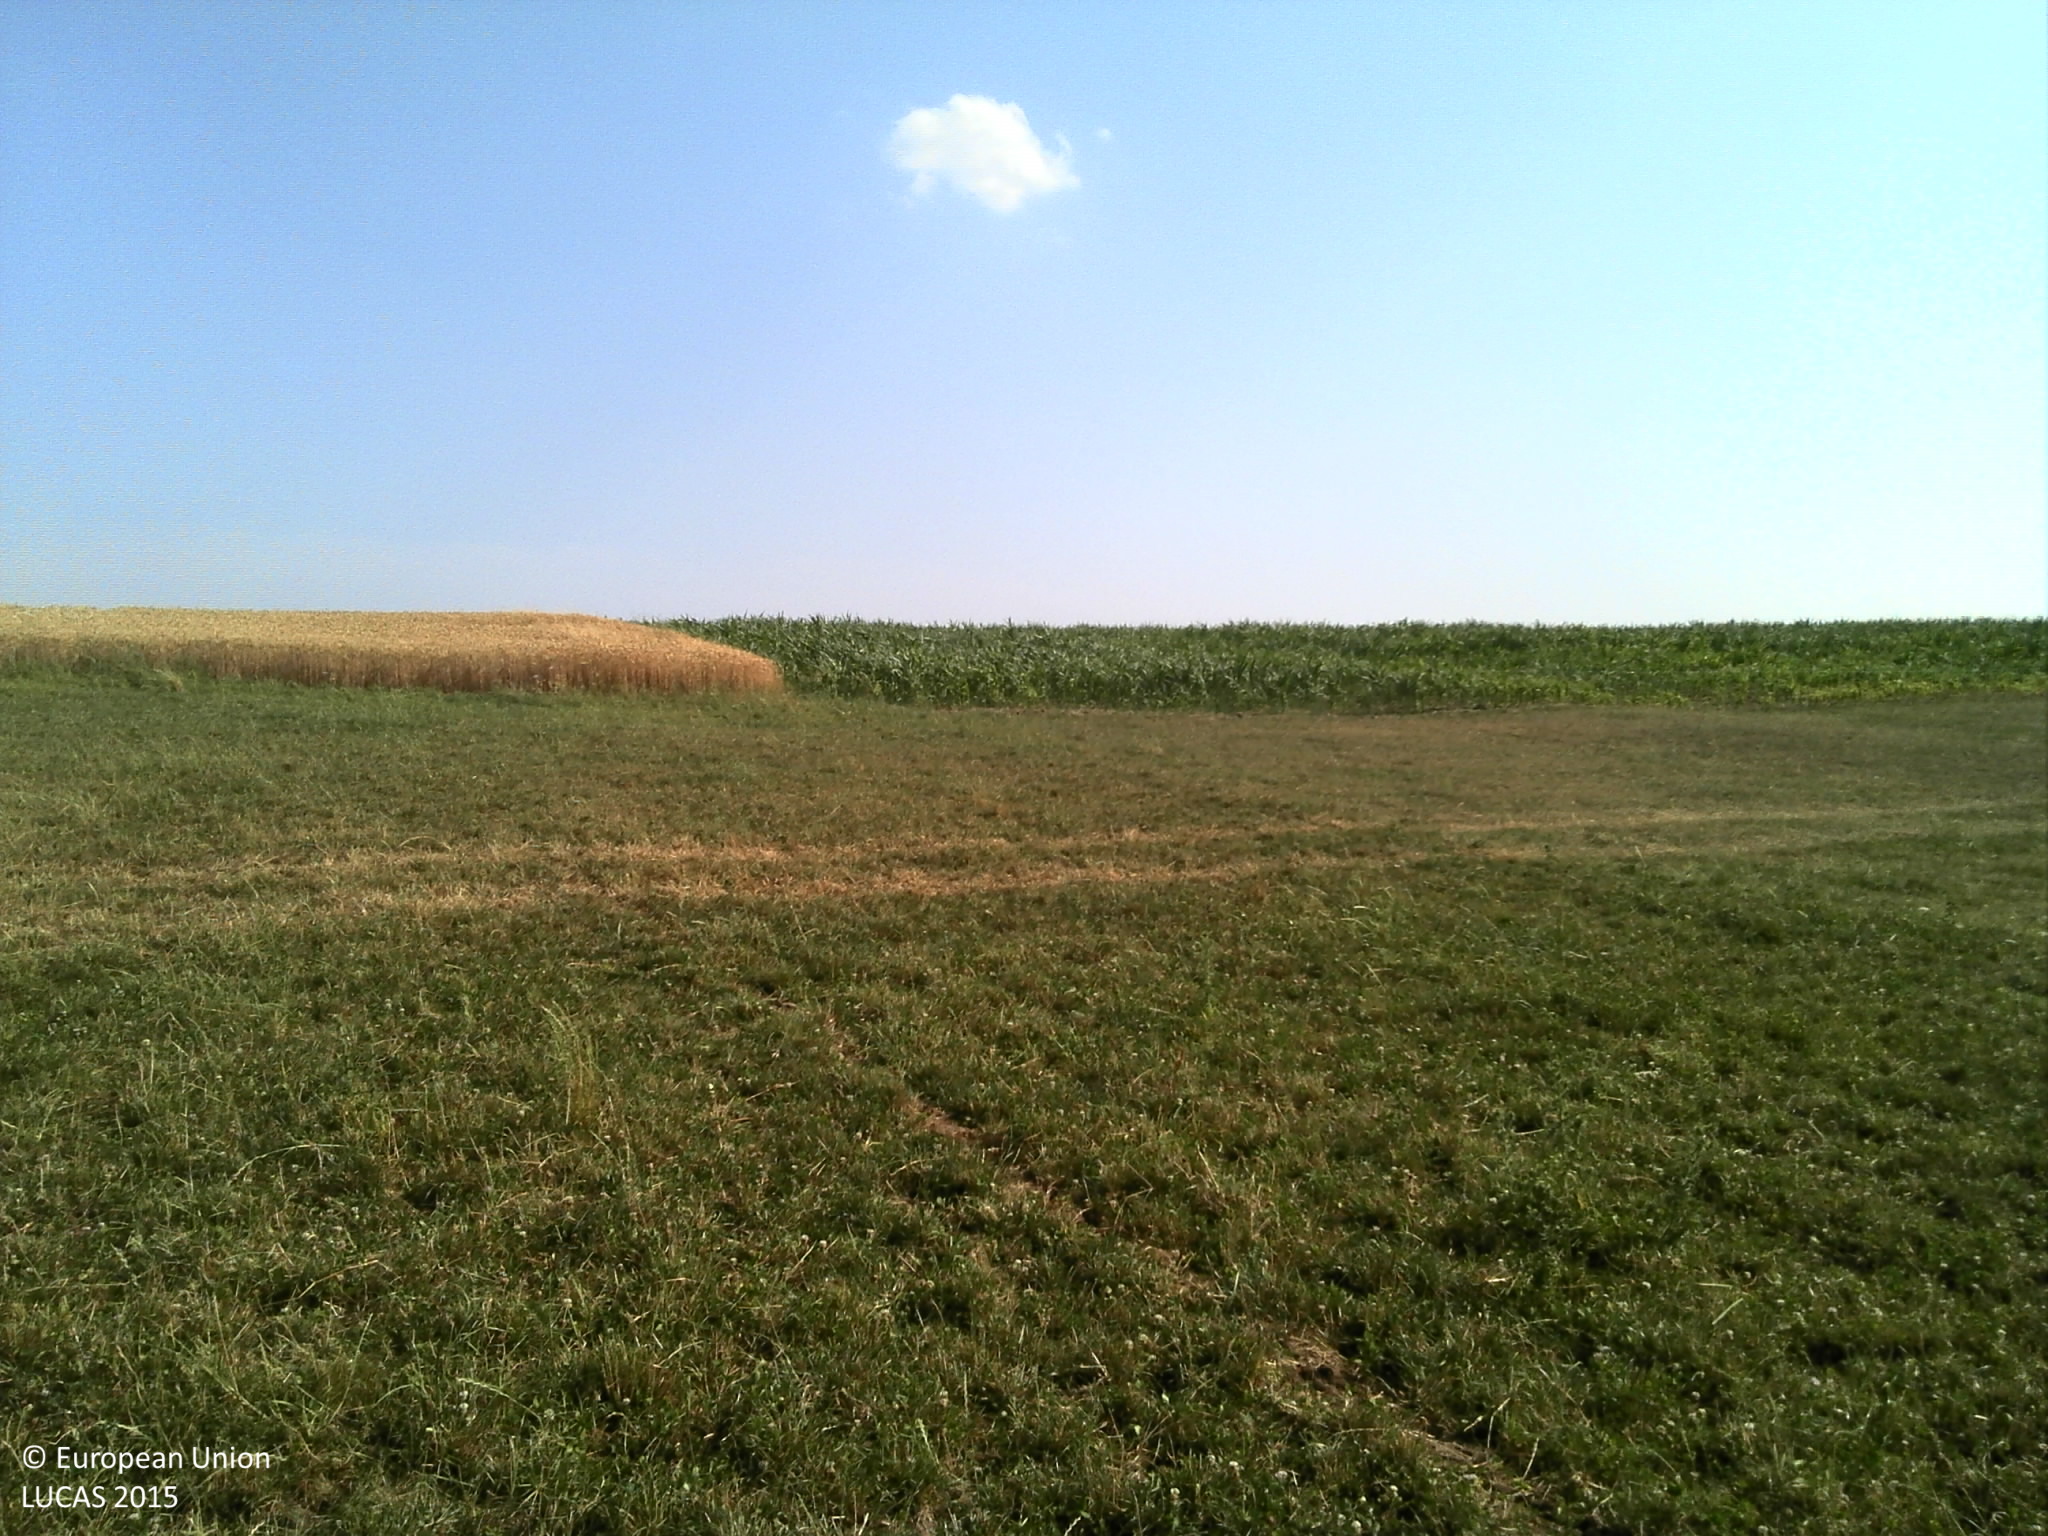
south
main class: Grassland
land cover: Grassland without tree/shrub cover
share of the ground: > 75 %
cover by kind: herbaceous plants 100 %
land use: Agriculture (excluding fallow land and kitchen gardens)
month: July
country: FR
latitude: 48.9152
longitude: 6.7936
